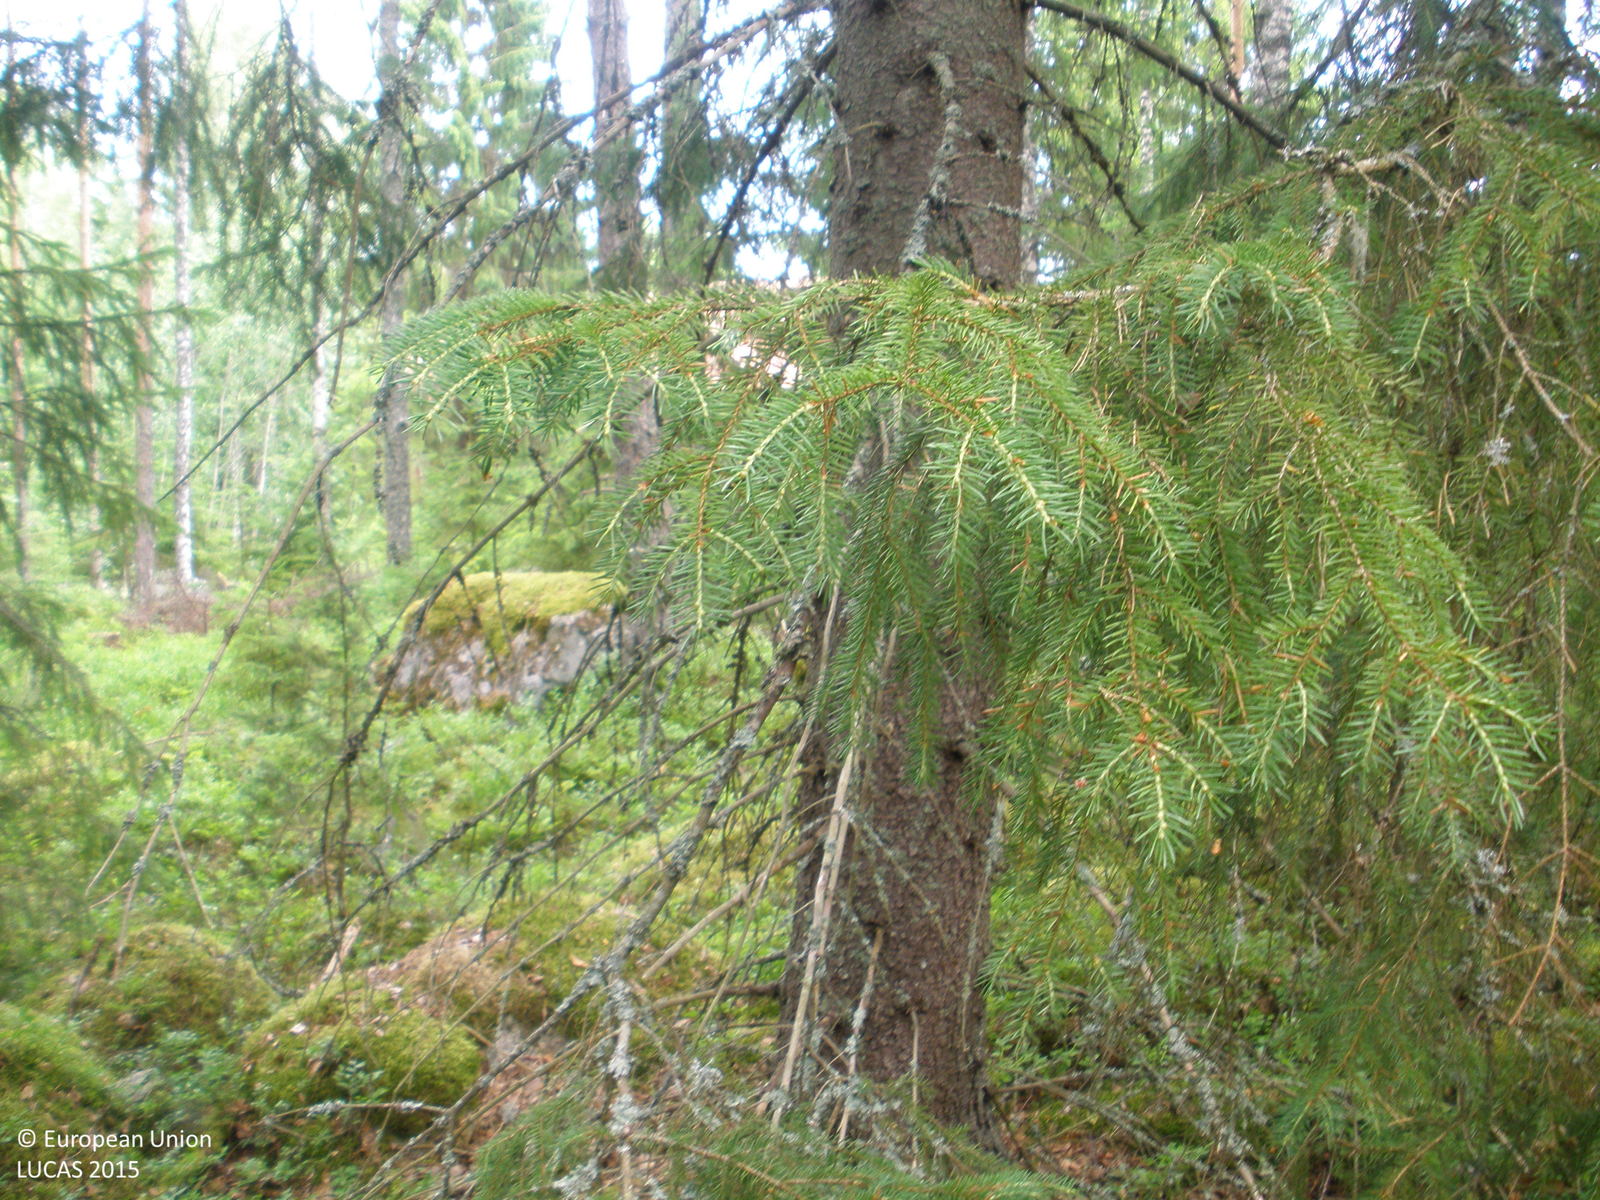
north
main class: Woodland
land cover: Other coniferous woodland
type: boreal forest
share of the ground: > 75 %
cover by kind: coniferous forest trees 70 %, broadleaved forest trees 15 %, lichens and mosses 10 %, herbaceous plants 5 %
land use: Forestry
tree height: > 5 m
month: July
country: FI
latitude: 60.9083
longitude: 23.2252
